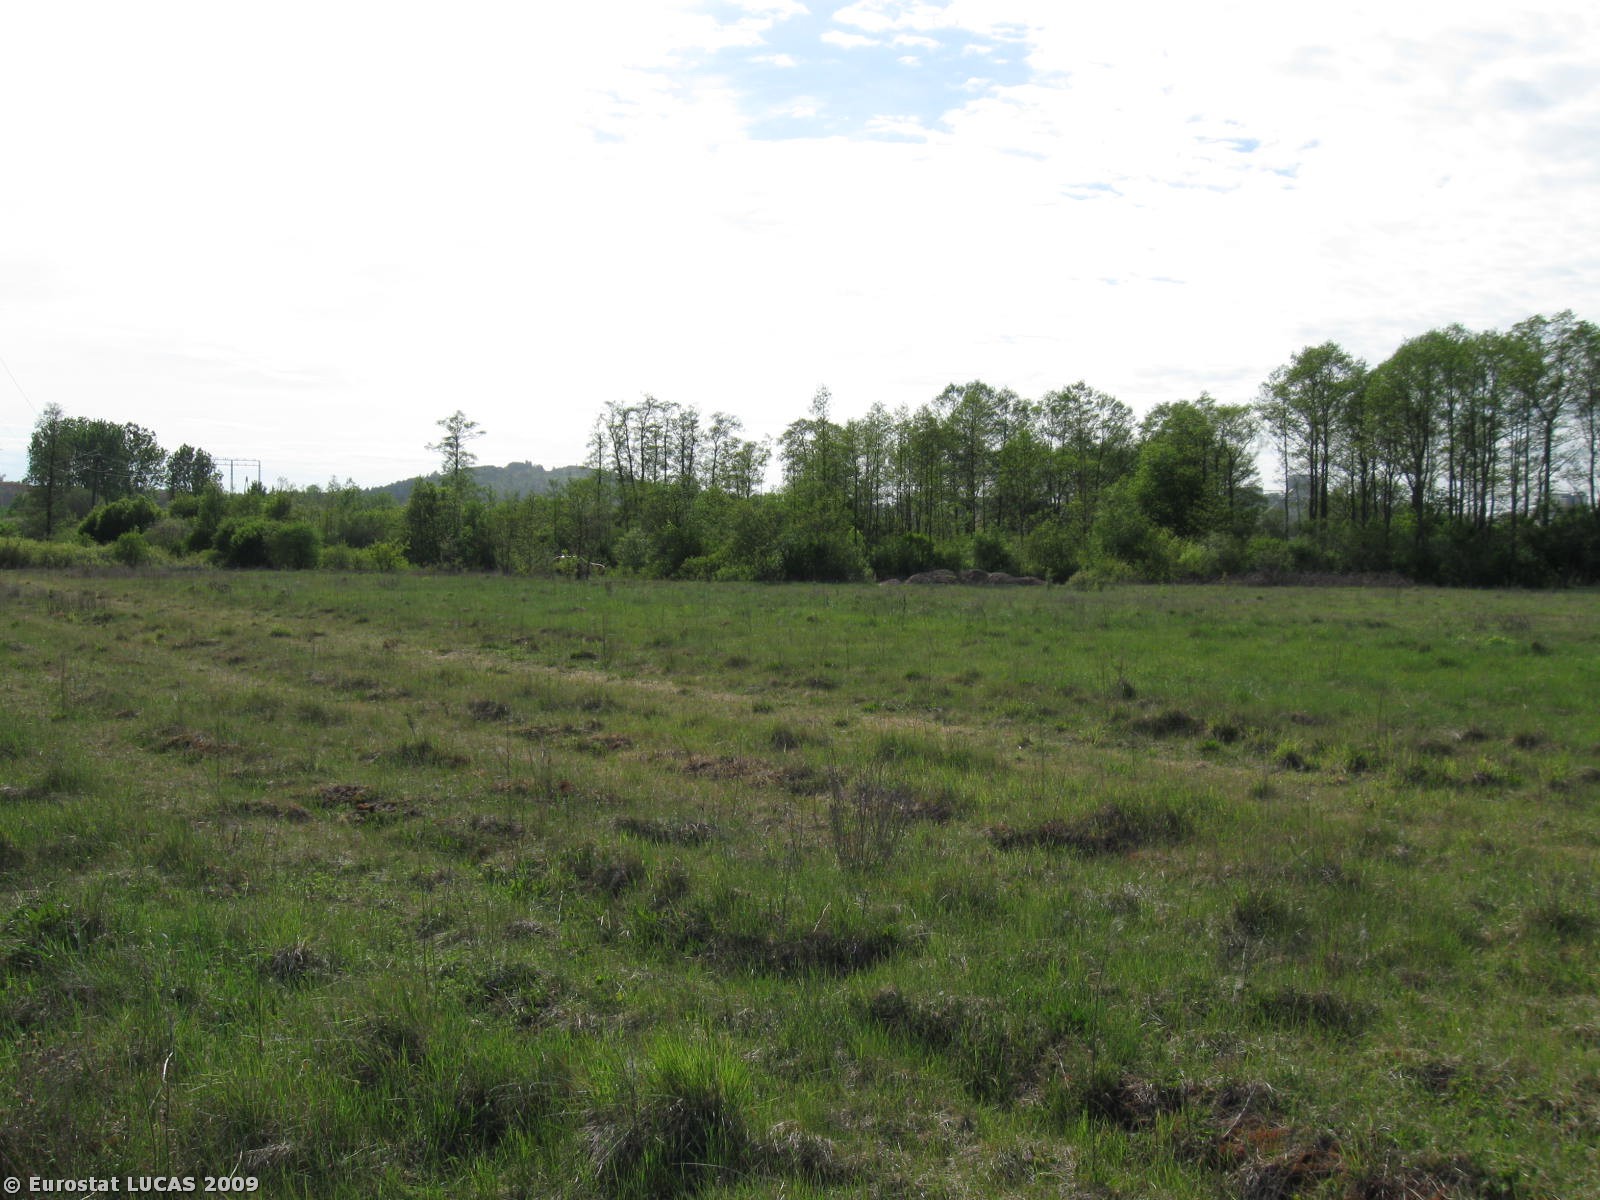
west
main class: Grassland
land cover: Grassland without tree/shrub cover
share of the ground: > 75 %
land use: Agriculture (excluding fallow land and kitchen gardens)
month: May
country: PL
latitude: 50.8504
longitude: 20.3917
